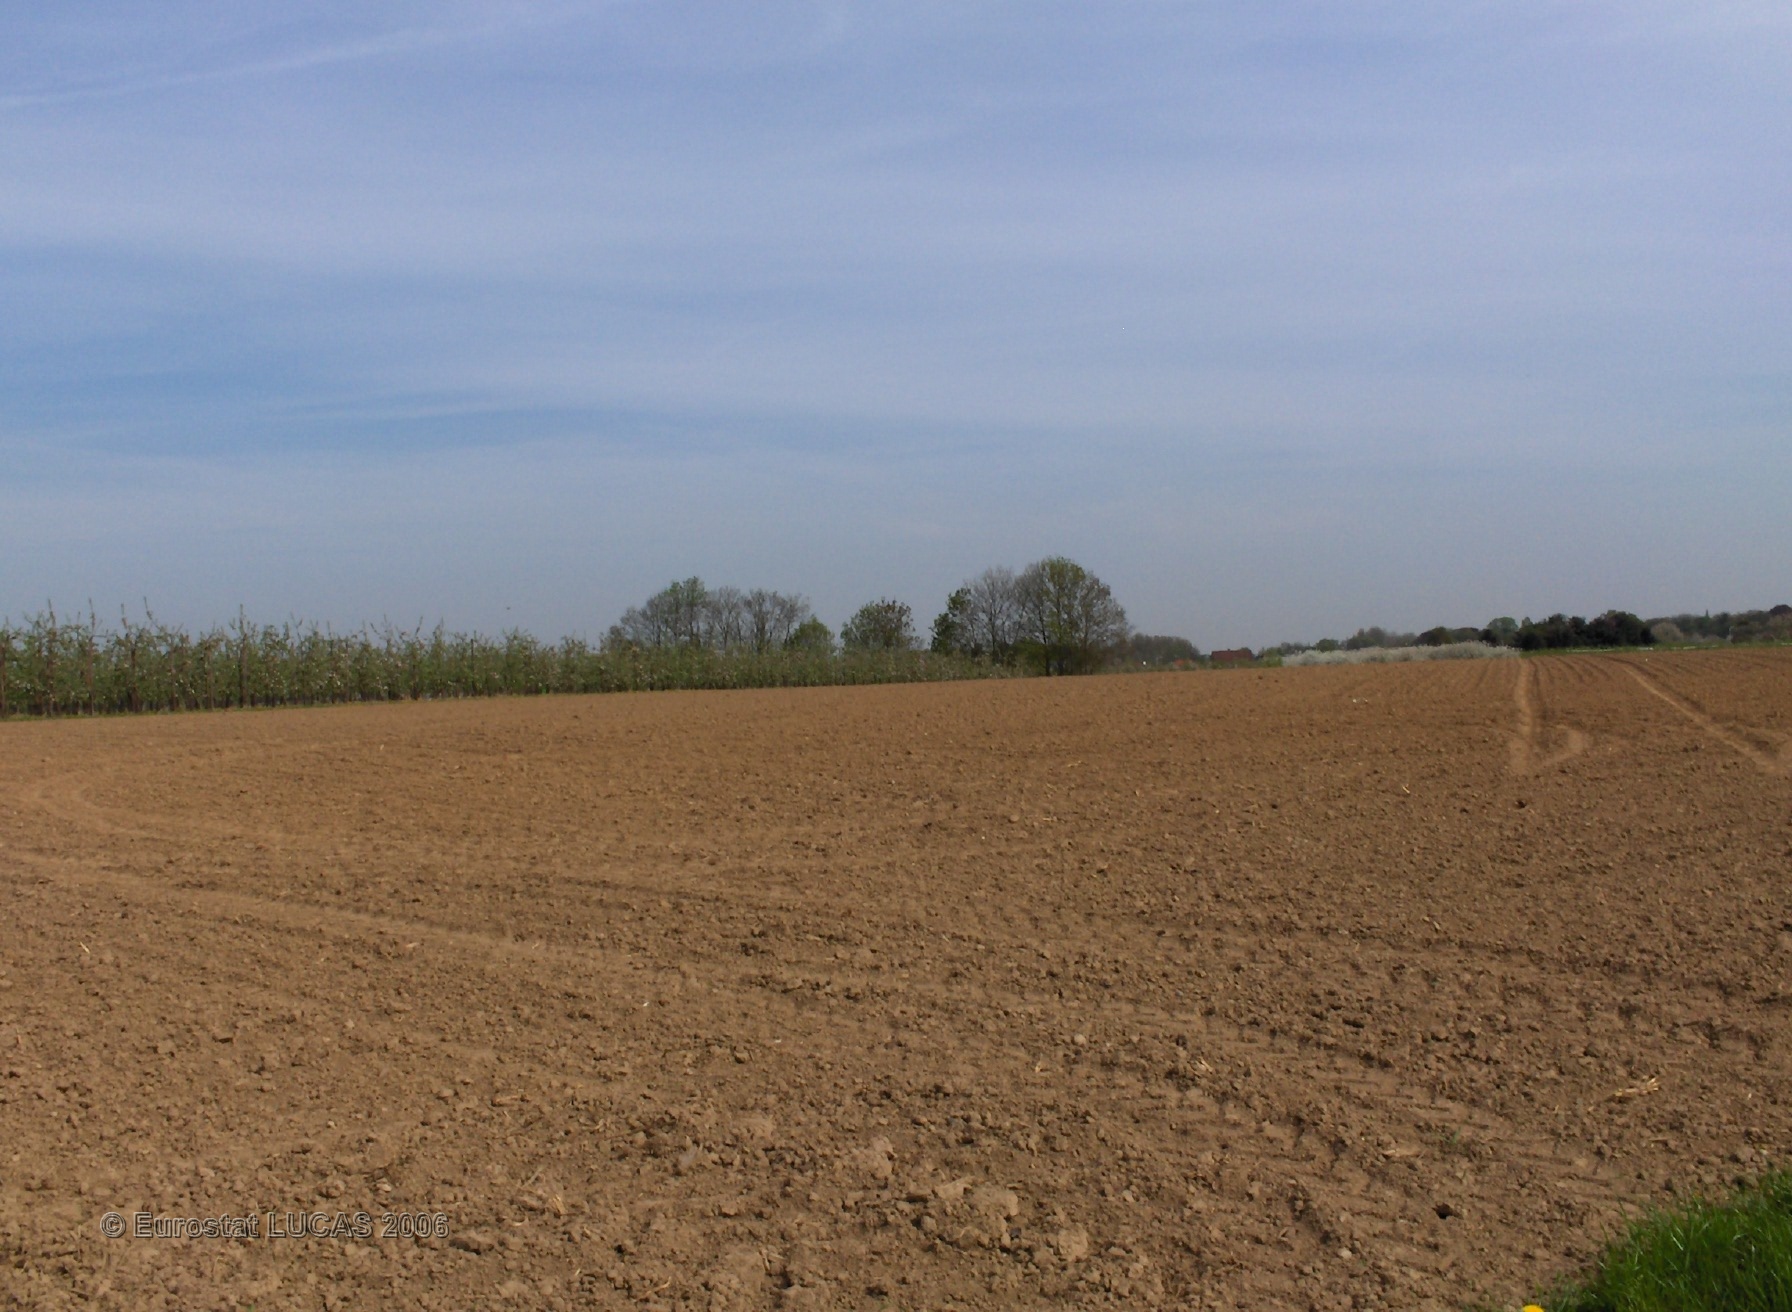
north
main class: Cropland
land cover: Other fibre and oleaginous crops
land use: Agriculture (excluding fallow land and kitchen gardens)
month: May
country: BE
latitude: 50.7864
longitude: 5.2174
